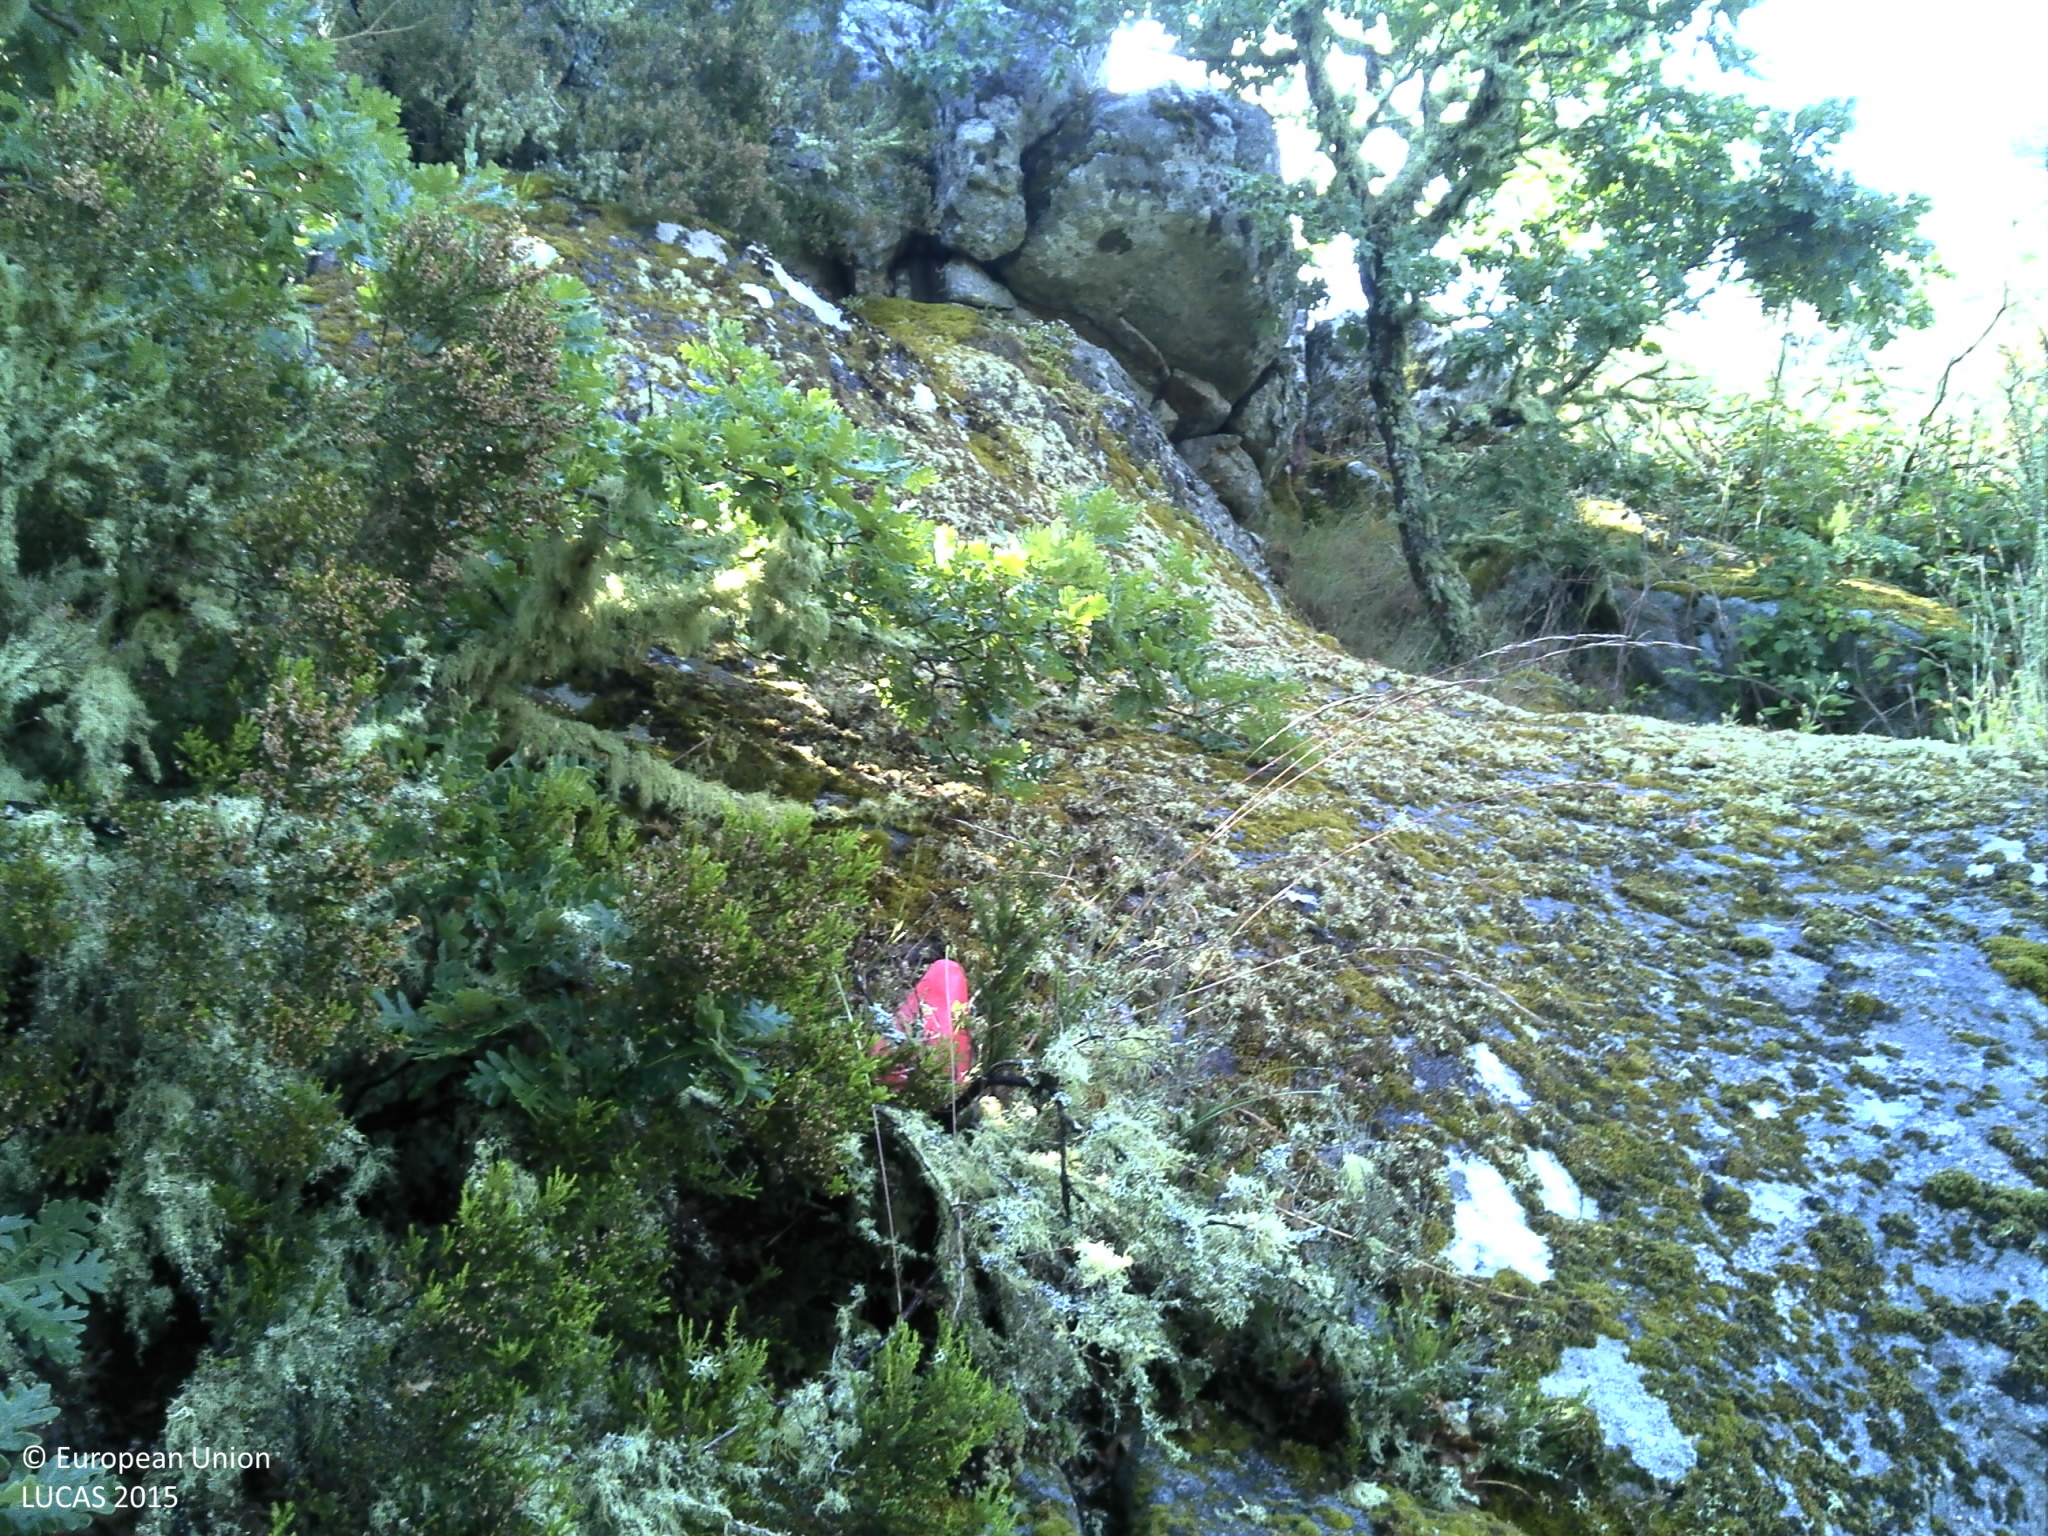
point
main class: Woodland
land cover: Broadleaved woodland
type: acidophilous oak and oak-birch forest
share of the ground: 10 - 25 %
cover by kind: consolidated bare surface 50 %, shrubs 20 %, broadleaved forest trees 15 %, herbaceous plants 10 %, unconsolidated bare surface 5 %
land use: Semi-natural and natural areas not in use
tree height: > 5 m
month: June
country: PT
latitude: 41.0827
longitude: -7.5851
